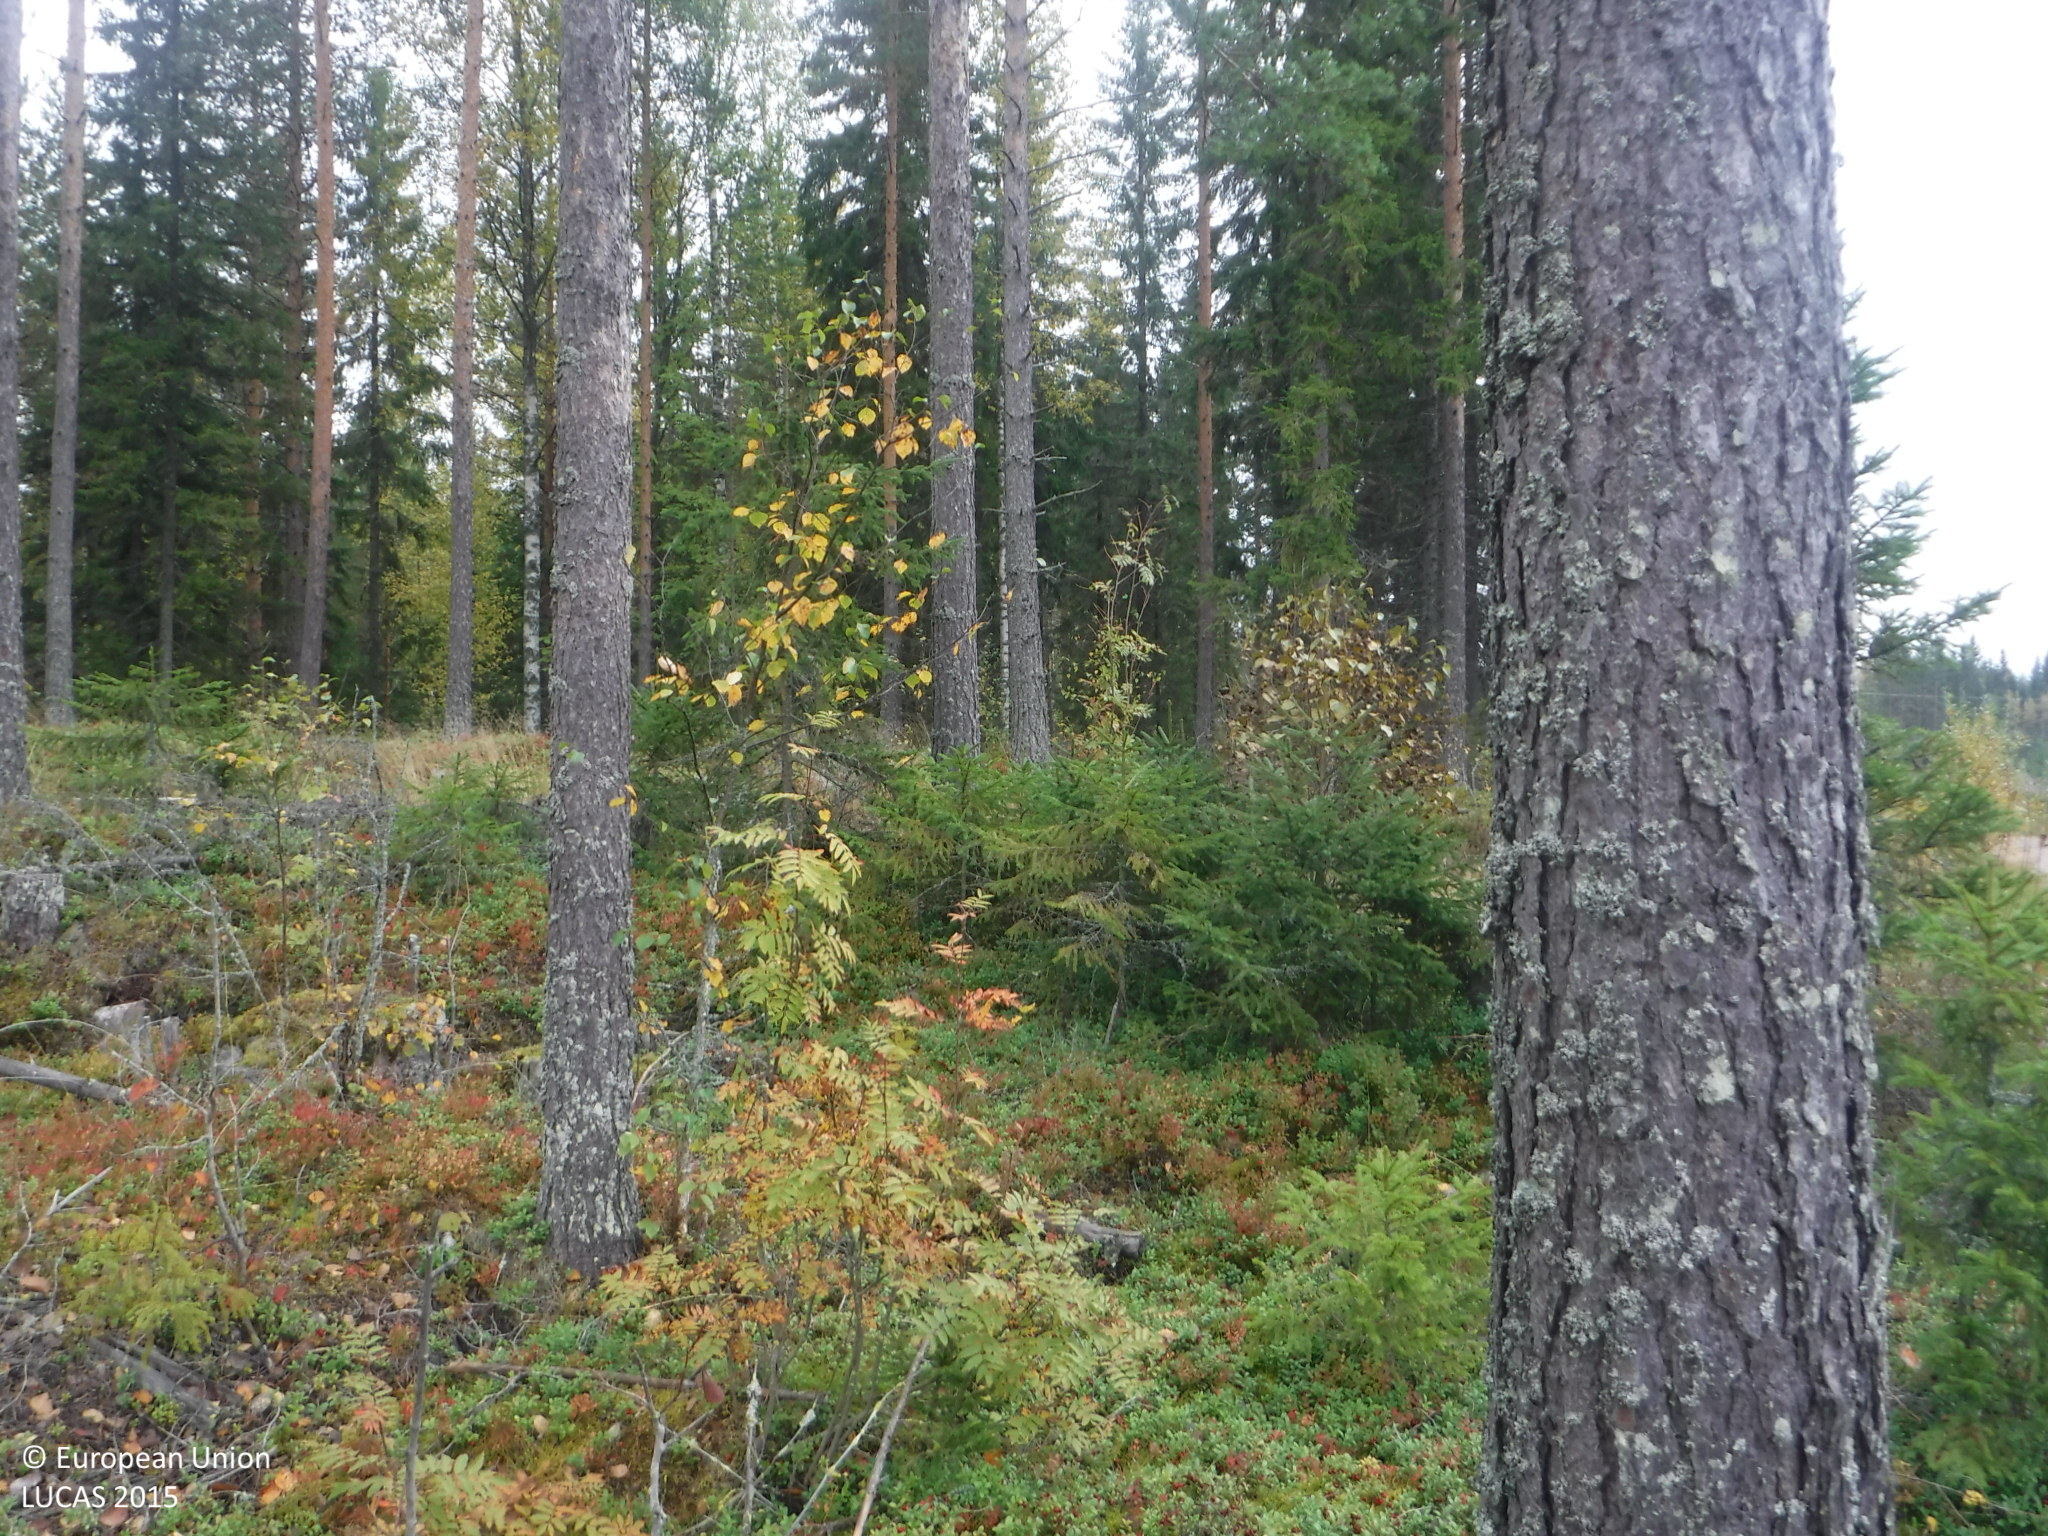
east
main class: Woodland
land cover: Pine dominated coniferous woodland
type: boreal forest
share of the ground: 10 - 25 %
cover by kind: shrubs 60 %, lichens and mosses 25 %, coniferous forest trees 15 %
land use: Forestry
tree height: > 5 m
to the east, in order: Pine dominated coniferous woodland; Spruce dominated coniferous woodland; Tracks; Shruby margins; Ditches and canals; Spontaneously vegetated surfaces; Electric lines; Spontaneously vegetated surfaces; Ditches and canals; Spontaneously vegetated surfaces; Ditches and canals; Spontaneously vegetated surfaces; Electric lines; Pine dominated mixed woodland; Tracks; Spontaneously vegetated surfaces
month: September
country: FI
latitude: 61.8392
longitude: 24.0471
